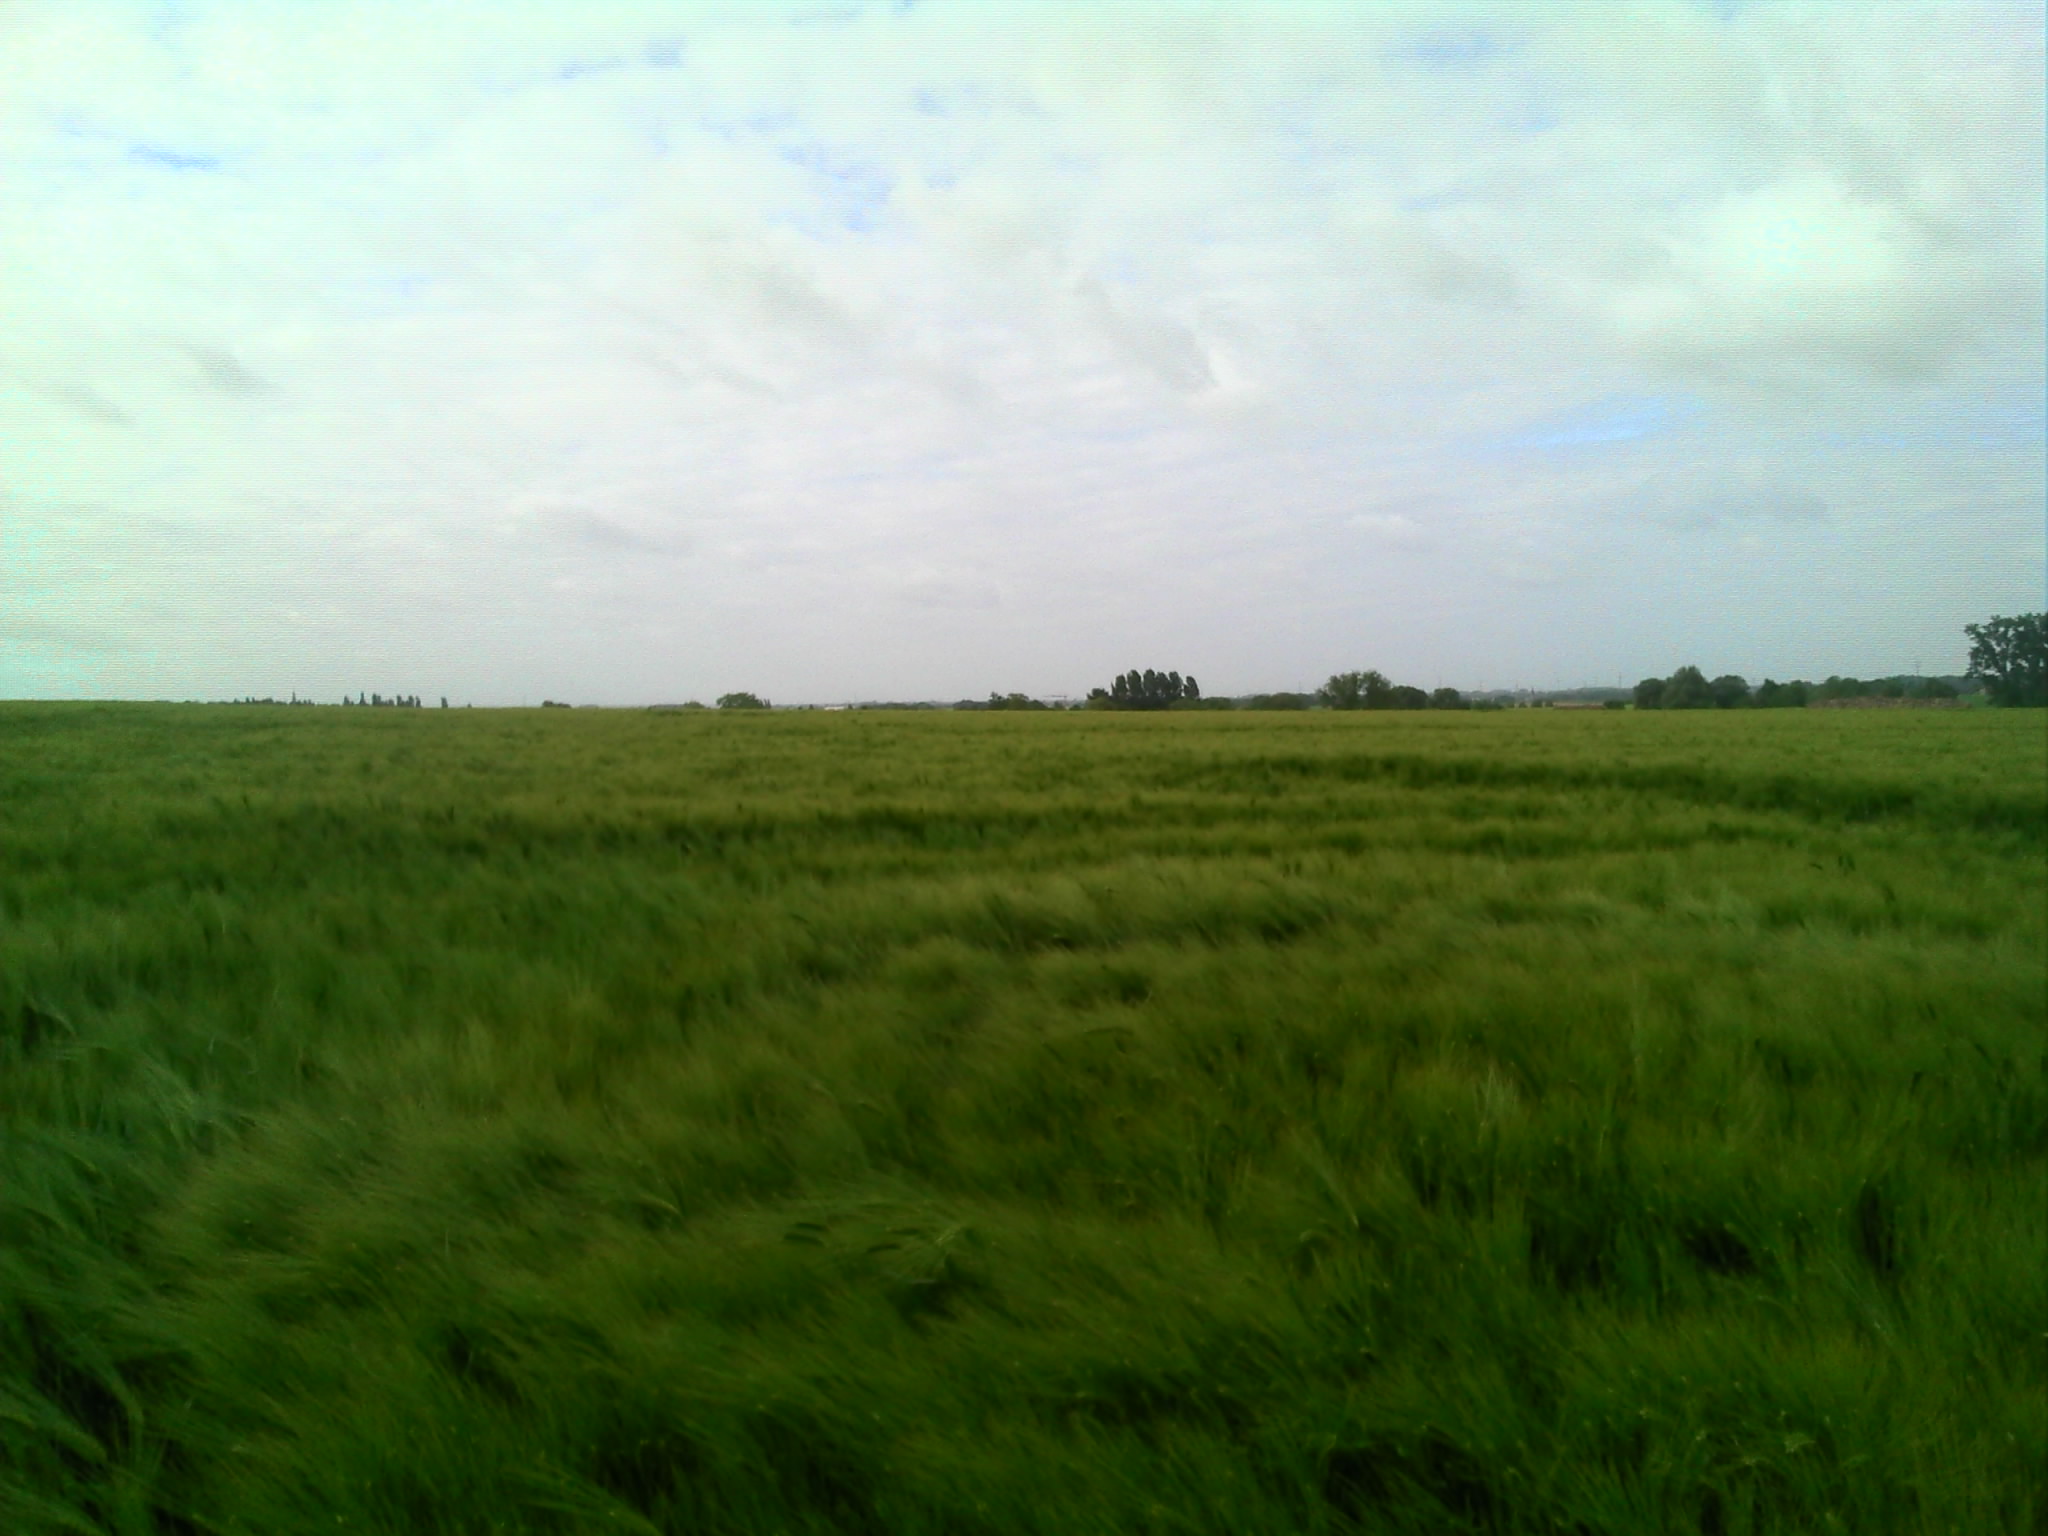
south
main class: Cropland
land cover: Barley
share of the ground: > 75 %
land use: Agriculture (excluding fallow land and kitchen gardens)
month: June
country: BE
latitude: 50.5425
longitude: 4.5916
